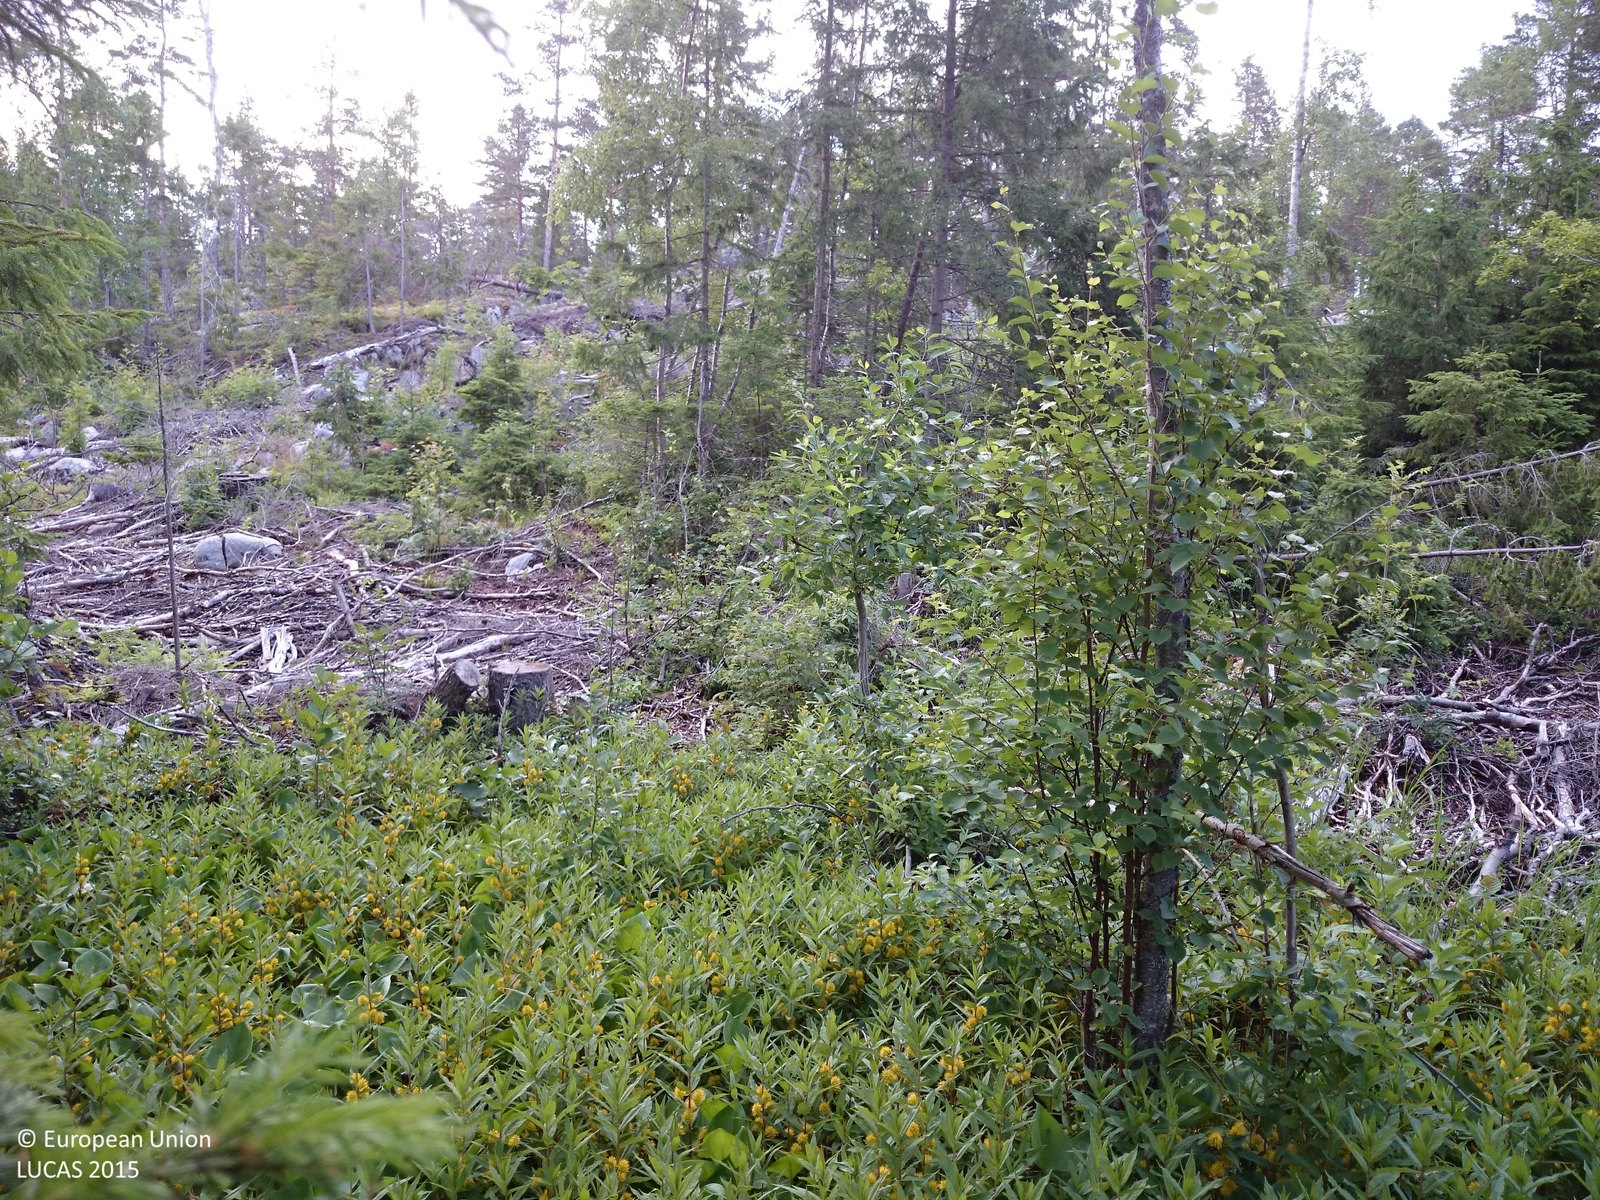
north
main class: Woodland
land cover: Broadleaved woodland
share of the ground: 50 - 75 %
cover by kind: broadleaved forest trees 45 %, herbaceous plants 40 %, coniferous forest trees 5 %
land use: Forestry
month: July
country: SE
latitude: 62.4387
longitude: 17.5942
